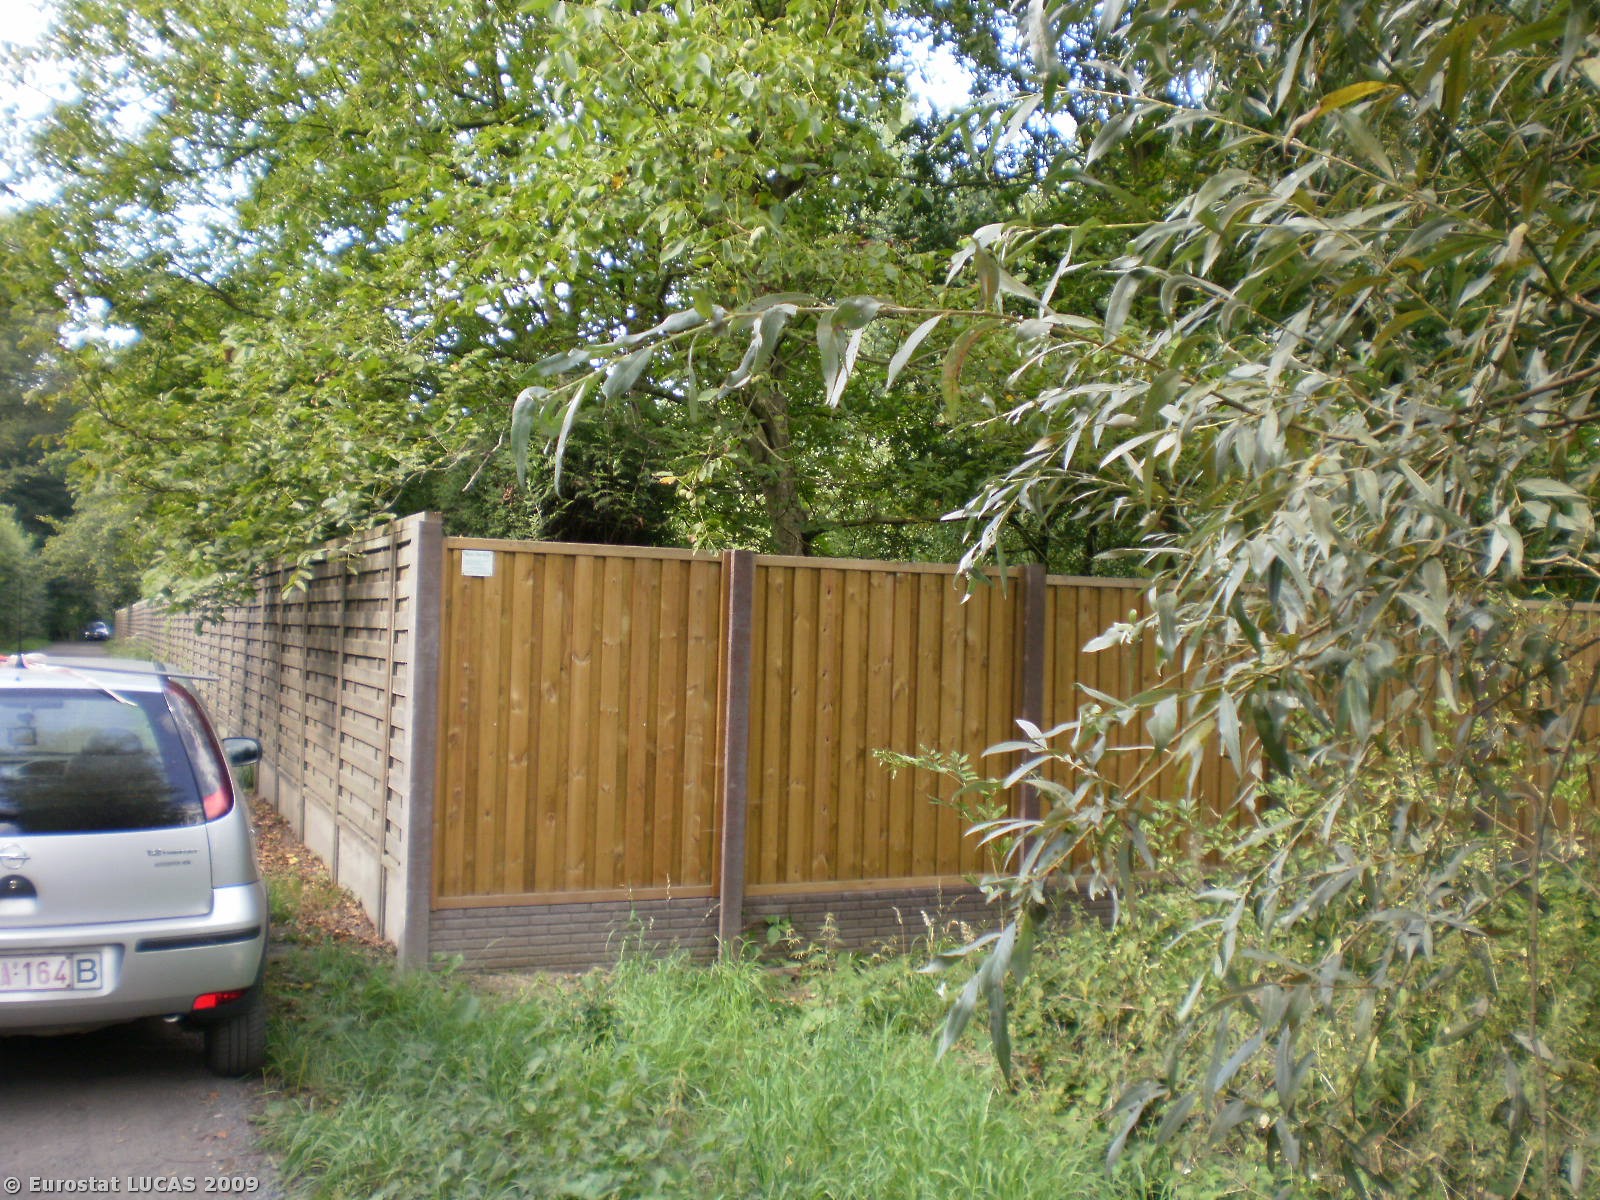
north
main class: Grassland
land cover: Grassland without tree/shrub cover
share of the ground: > 75 %
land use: Agriculture (excluding fallow land and kitchen gardens)
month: August
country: BE
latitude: 51.0621
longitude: 4.1587
